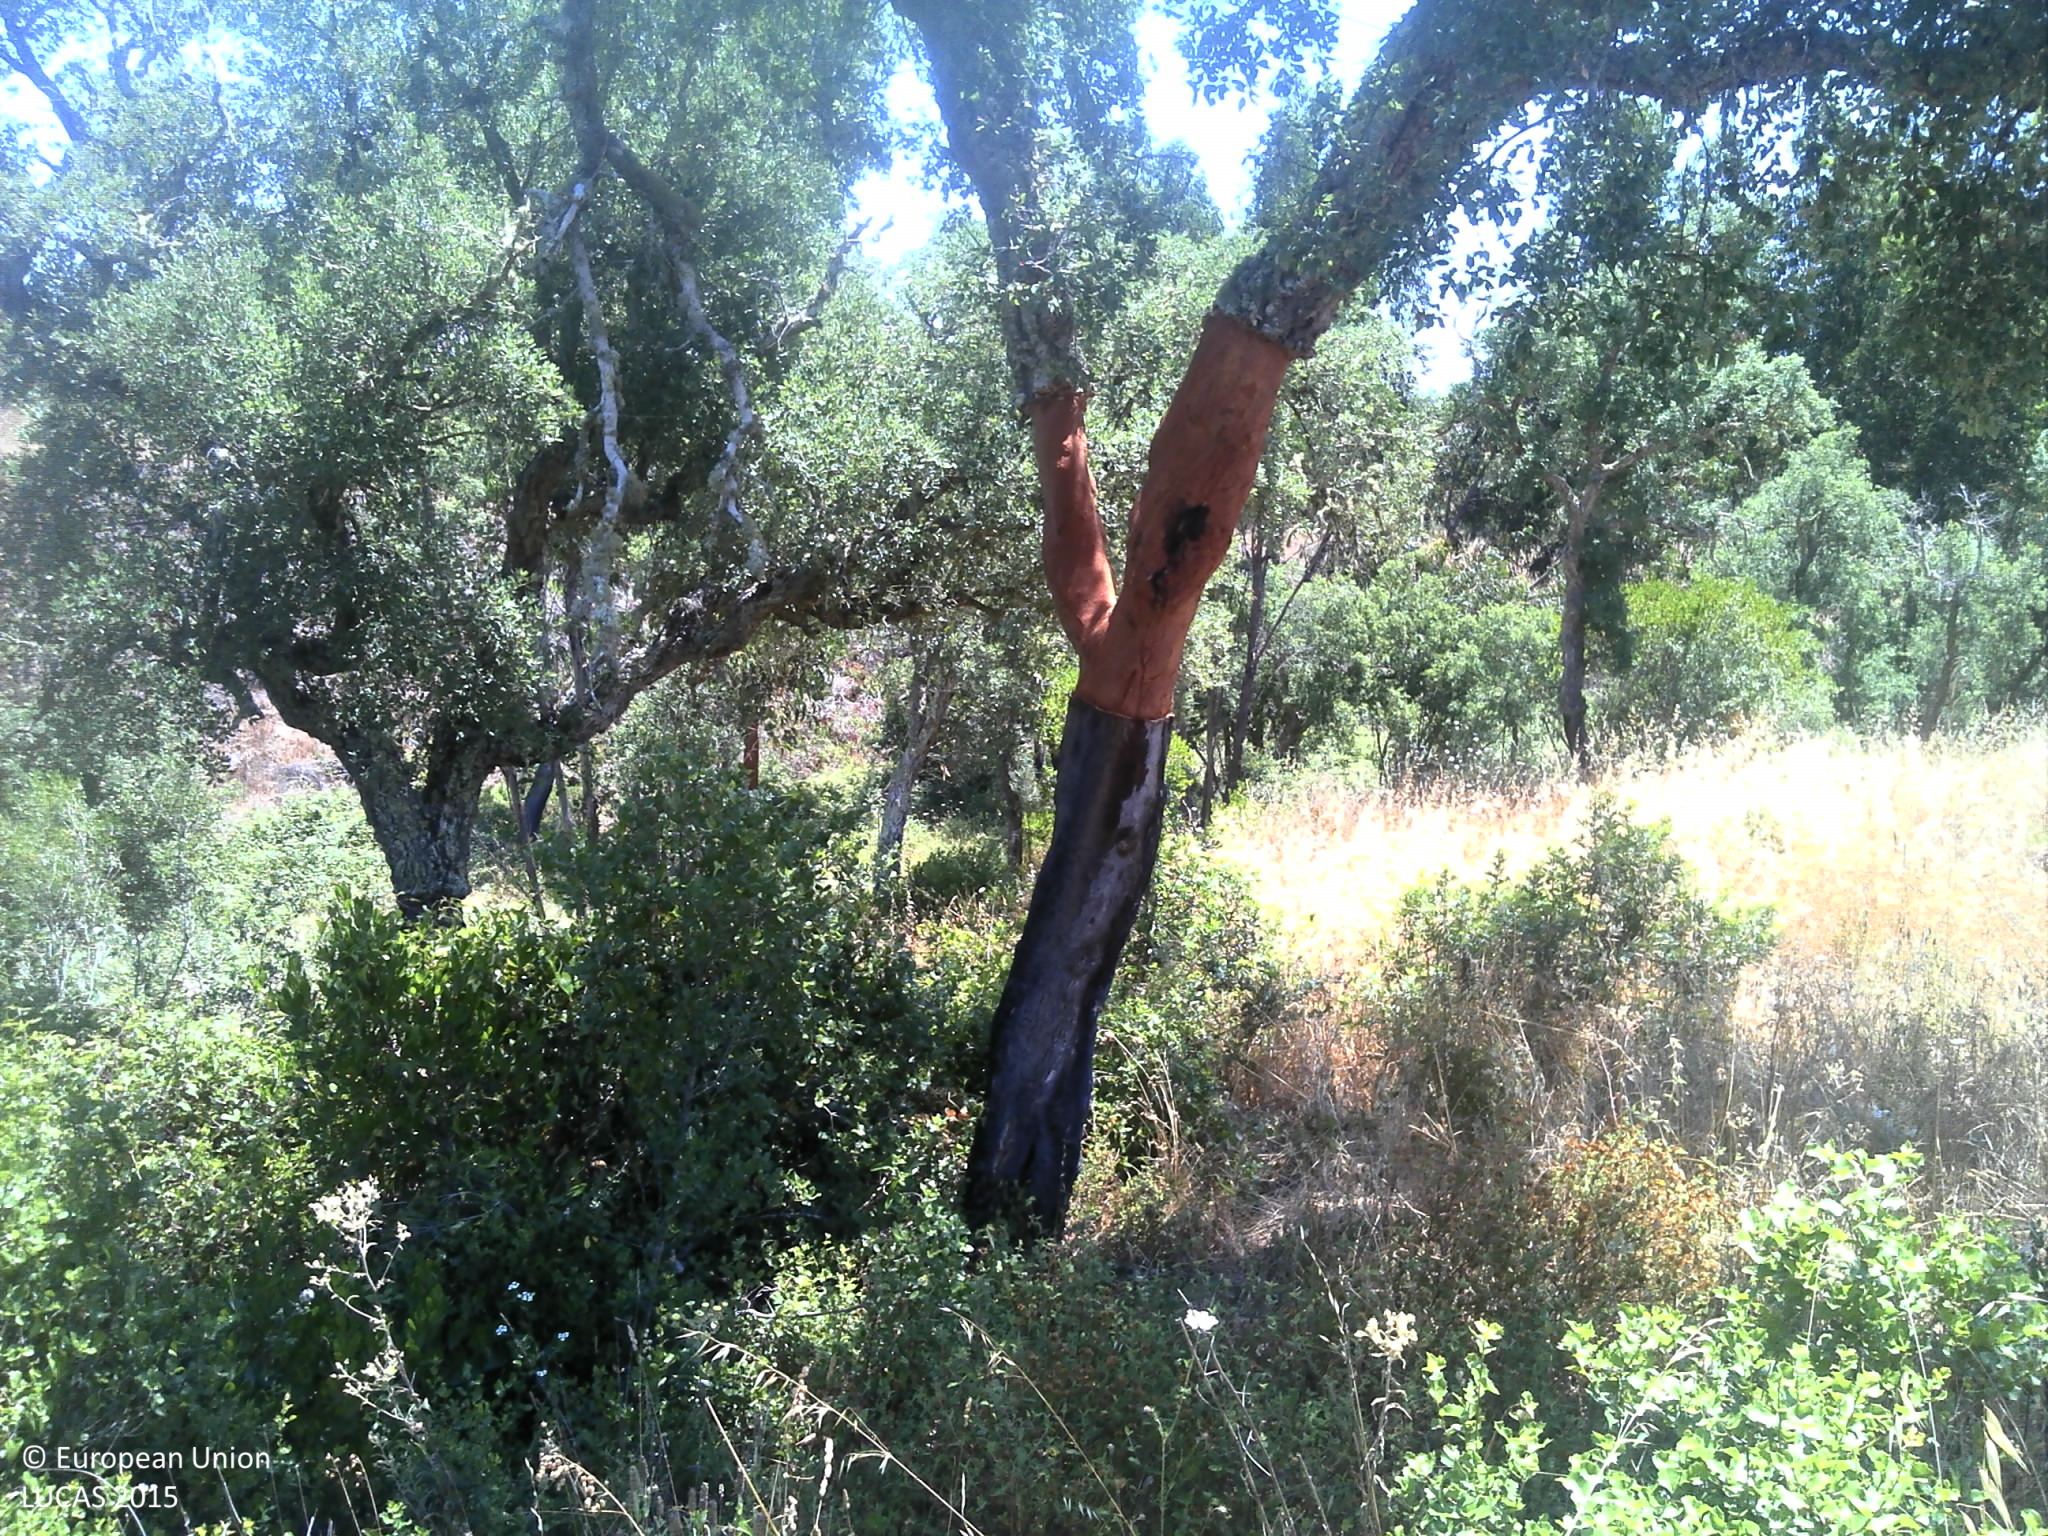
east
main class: Woodland
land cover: Broadleaved woodland
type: broadleaved evergreen forest
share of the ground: 25 - 50 %
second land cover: Shrubland without tree cover
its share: 25 - 50 %
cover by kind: broadleaved forest trees 30 %, herbaceous plants 30 %, shrubs 20 %, unconsolidated bare surface 20 %
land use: Forestry
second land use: Agriculture (excluding fallow land and kitchen gardens)
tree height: > 5 m
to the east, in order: Broadleaved woodland; Shrubland without tree cover; Broadleaved woodland; Rivers and streams; Shrubland with sparse tree cover; Grassland without tree/shrub cover; Broadleaved woodland; Grassland without tree/shrub cover; Broadleaved woodland; Grassland without tree/shrub cover
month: June
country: PT
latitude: 37.9599
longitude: -8.5619
